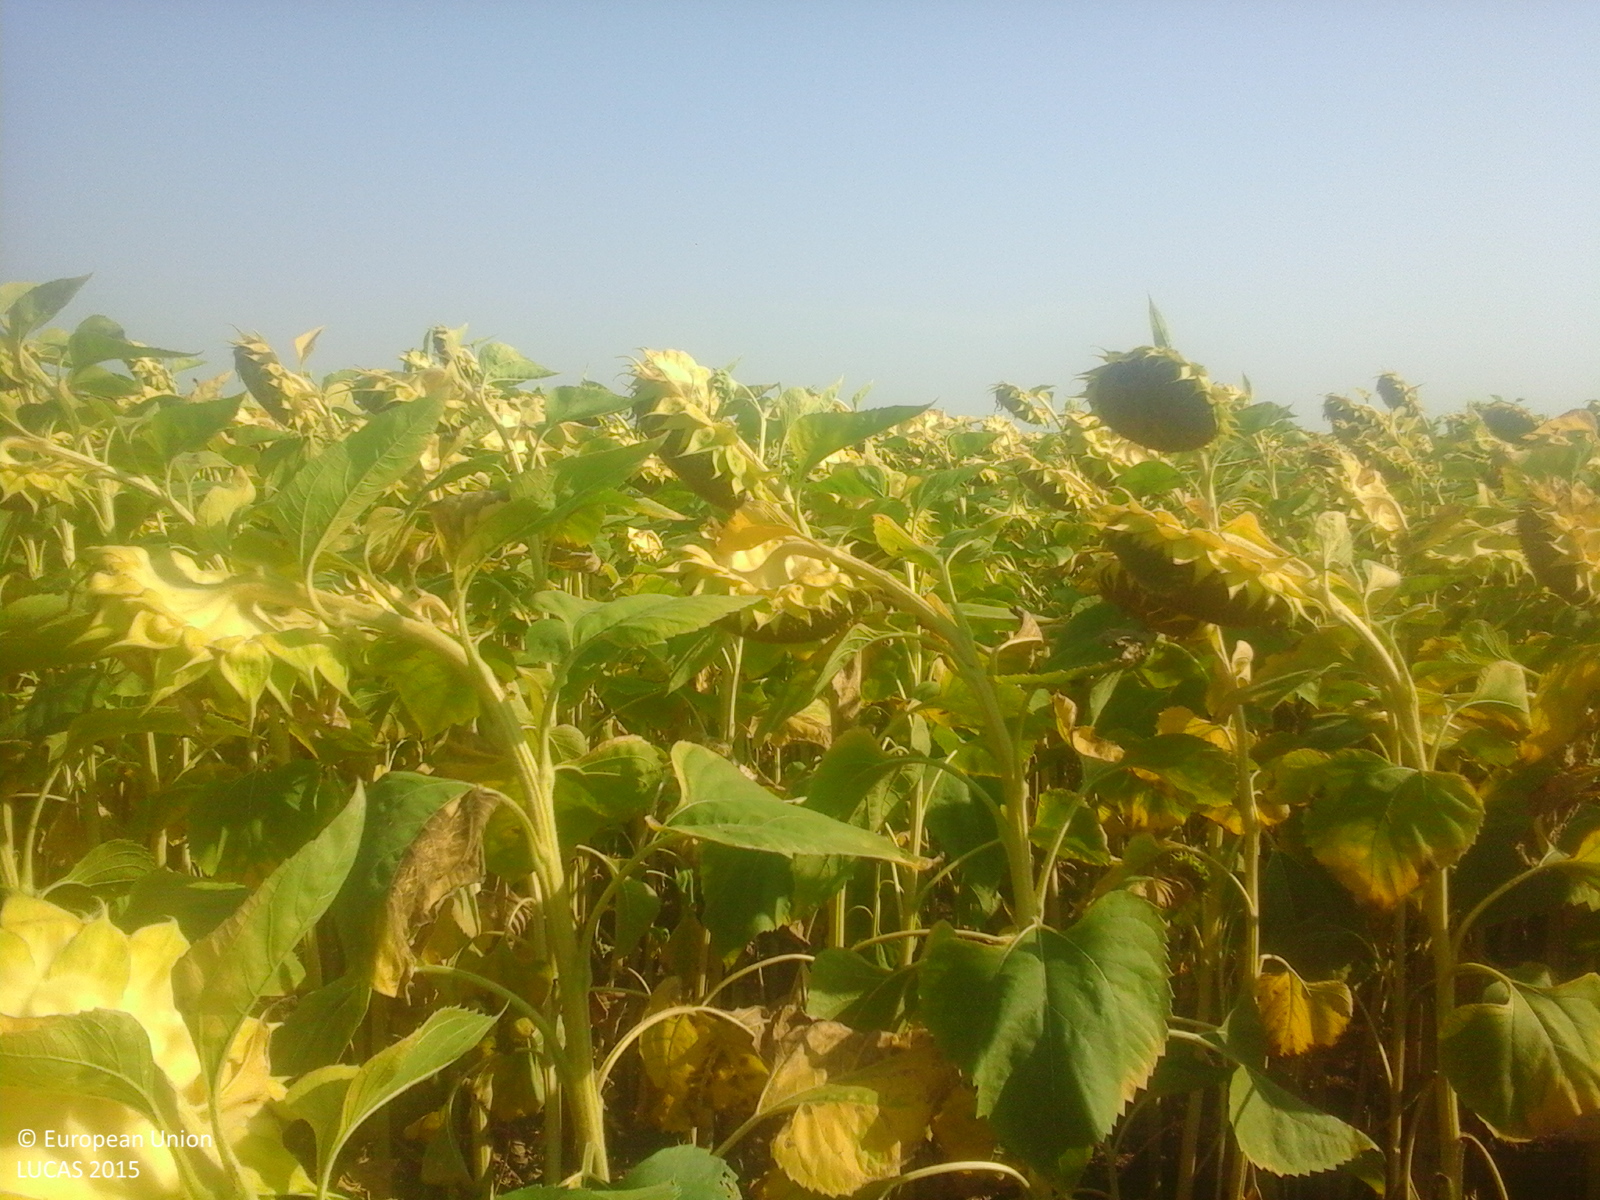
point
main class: Cropland
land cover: Sunflower
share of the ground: > 75 %
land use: Agriculture (excluding fallow land and kitchen gardens)
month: August
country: RO
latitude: 45.2159
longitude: 27.6645
